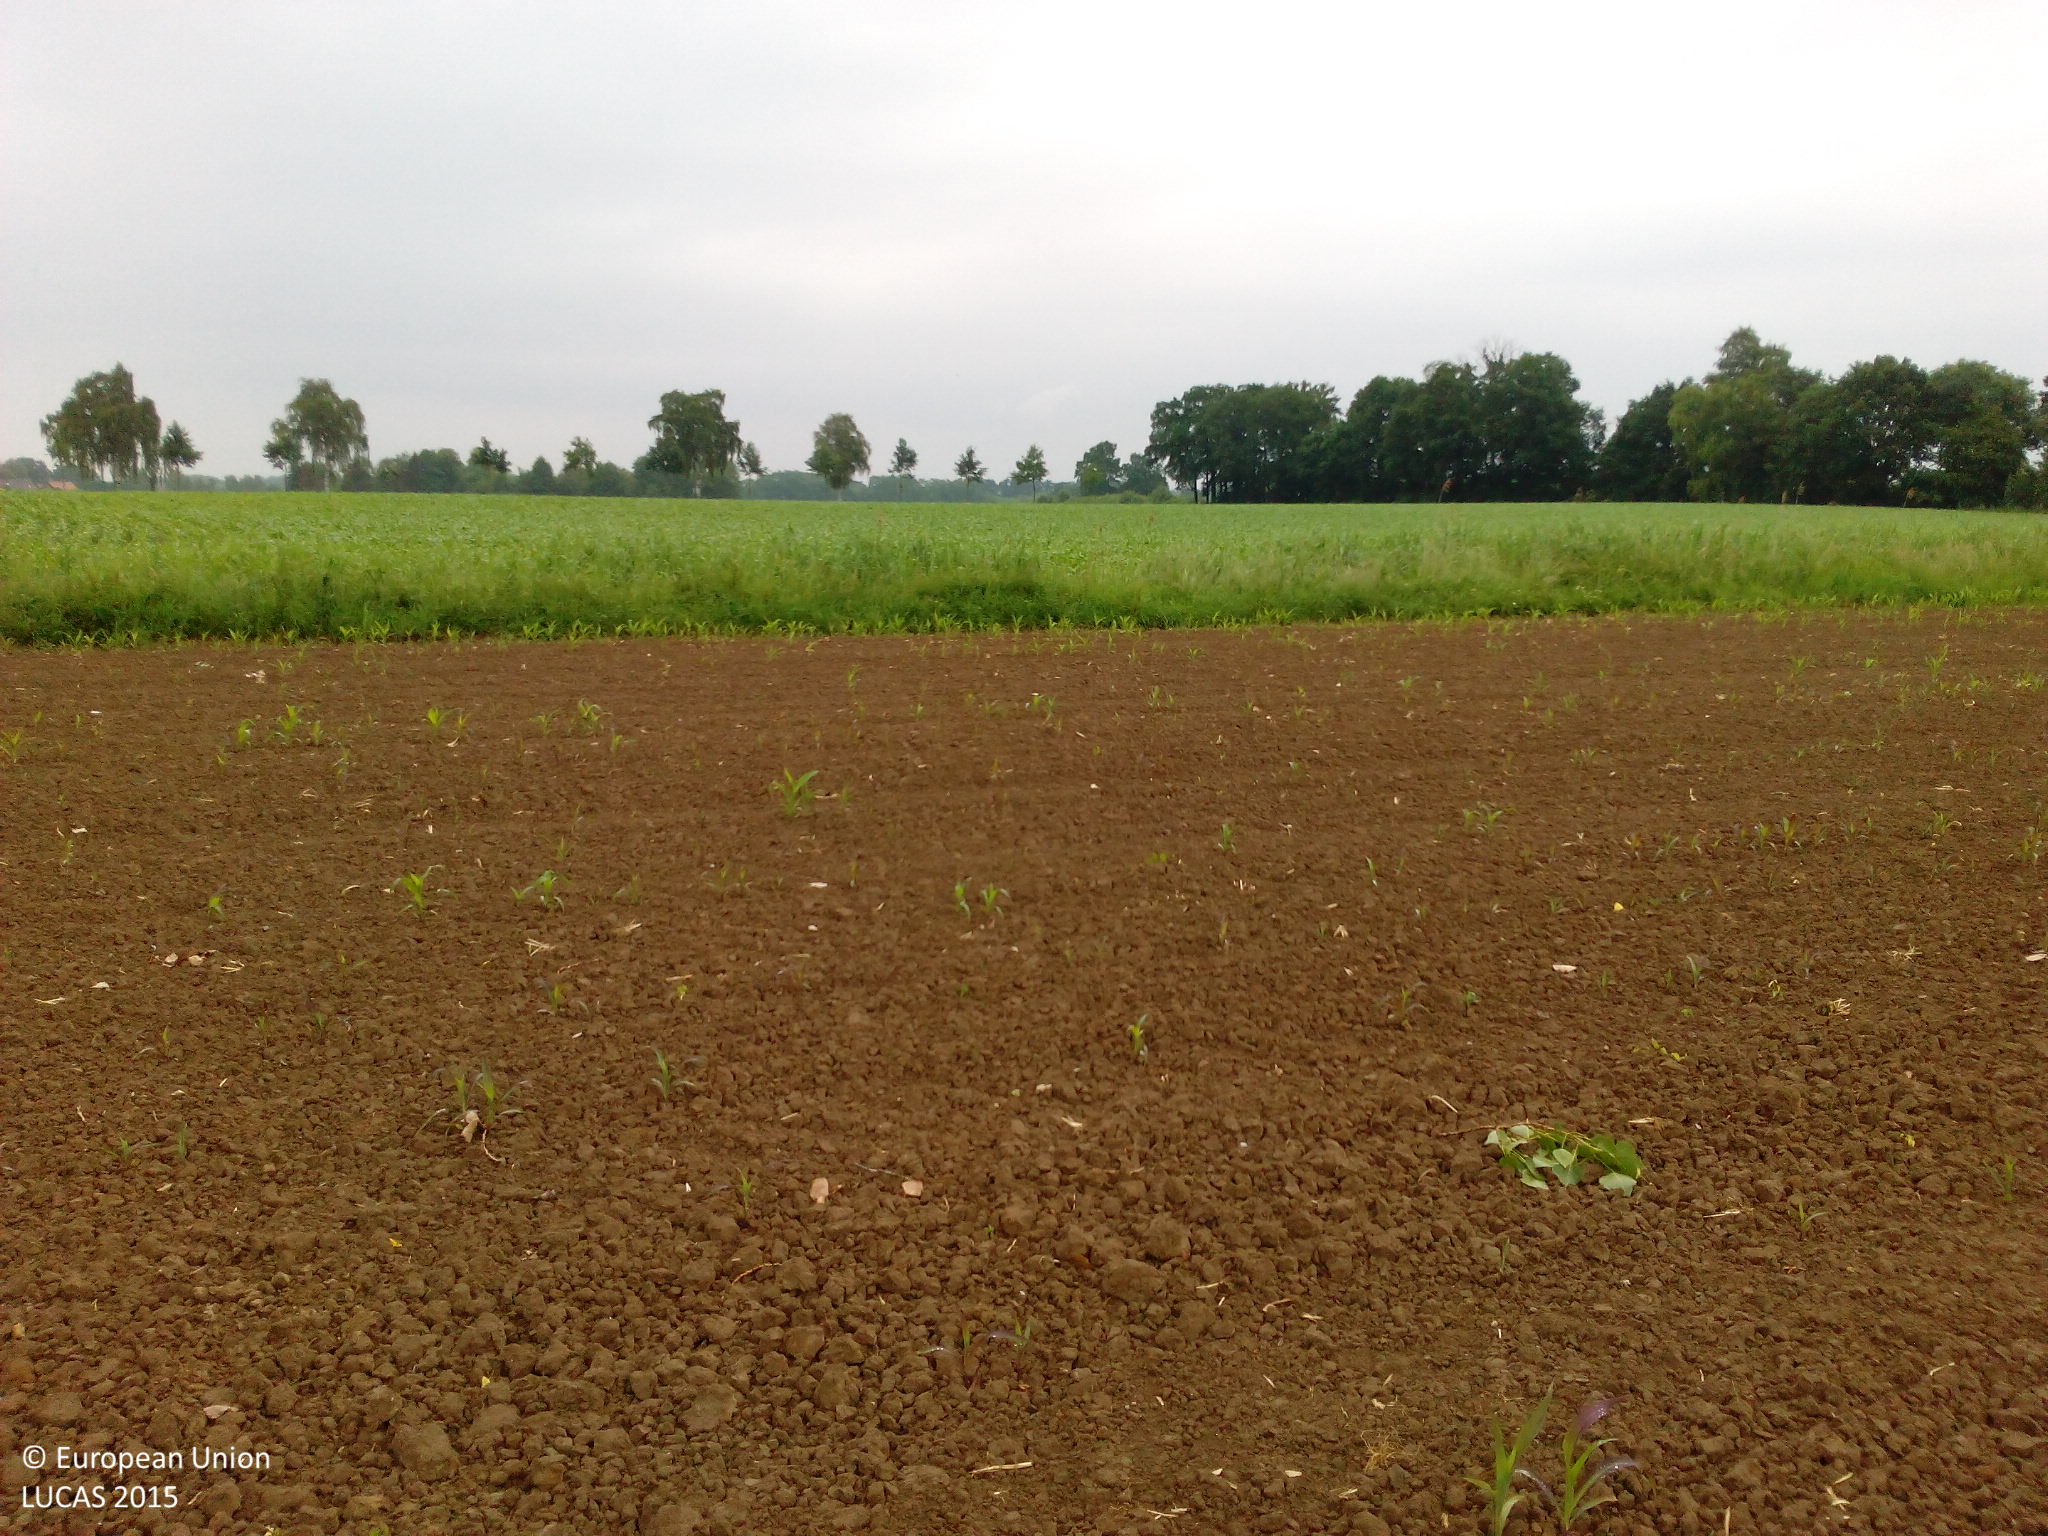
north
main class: Cropland
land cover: Maize
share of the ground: 10 - 25 %
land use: Agriculture (excluding fallow land and kitchen gardens)
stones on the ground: < 10 %
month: June
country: DE
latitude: 51.7018
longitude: 8.4232
